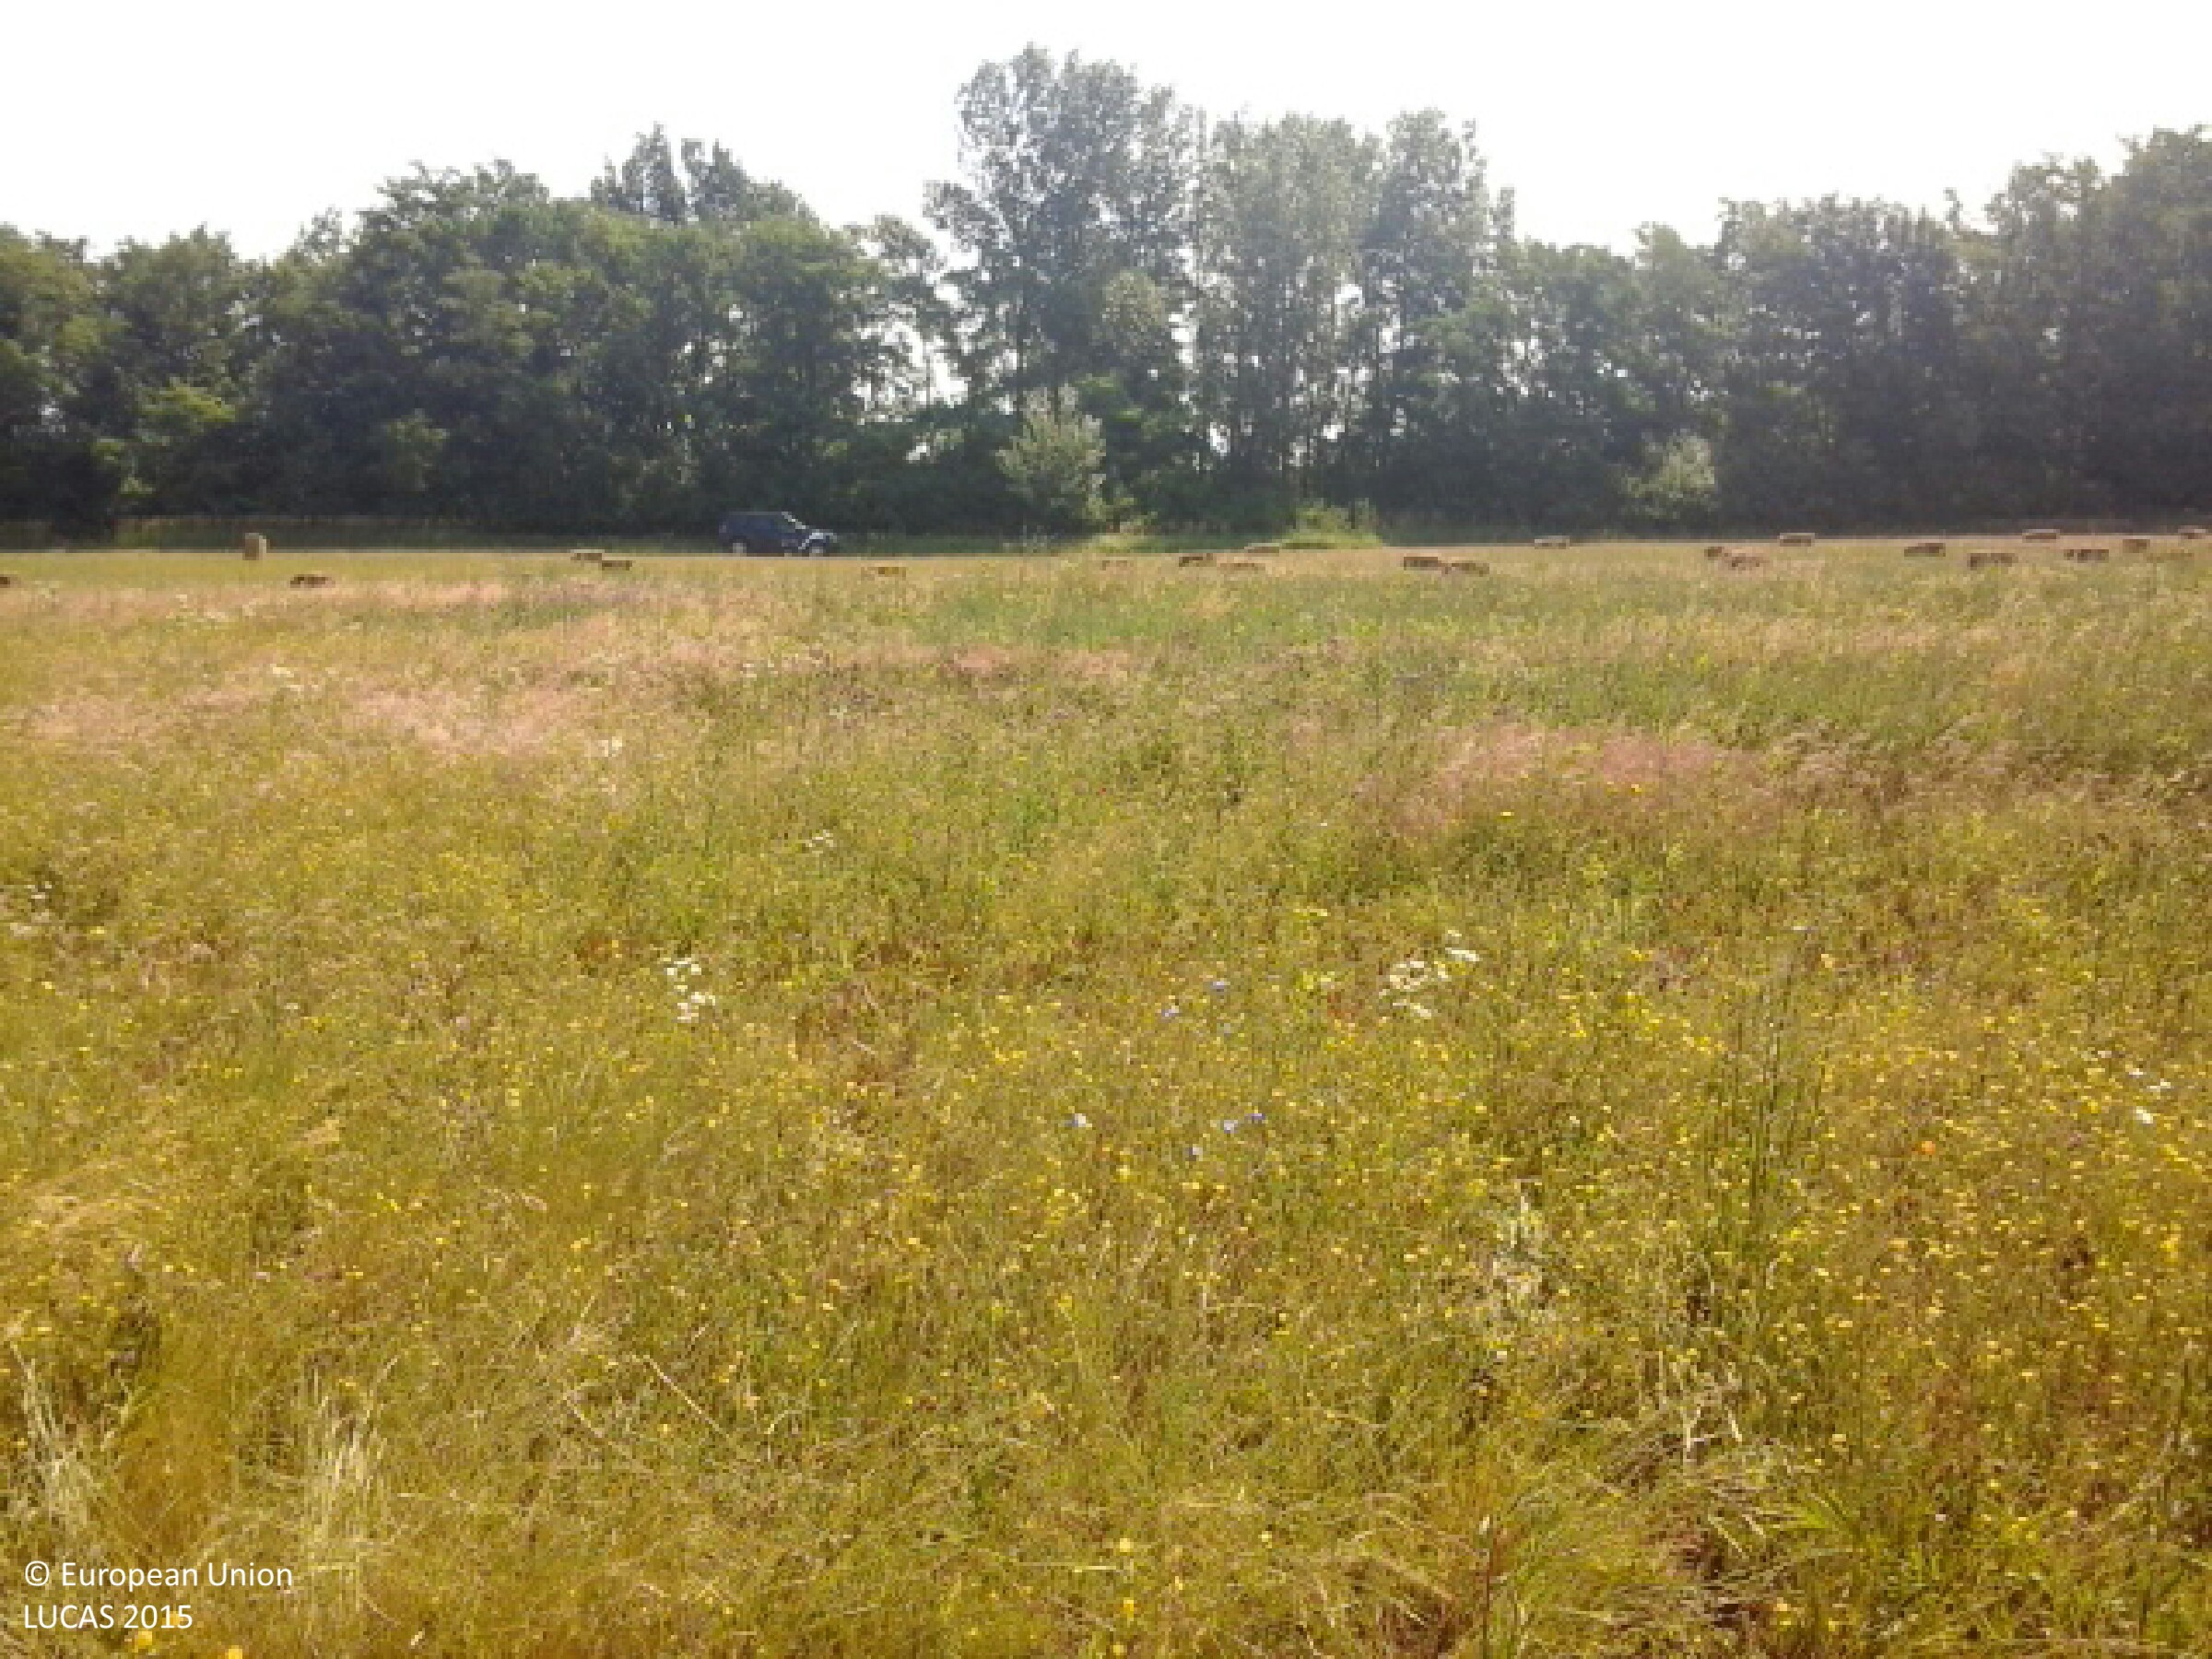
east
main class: Grassland
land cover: Grassland without tree/shrub cover
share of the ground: > 75 %
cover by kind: herbaceous plants 100 %
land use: Semi-natural and natural areas not in use
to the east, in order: Grassland without tree/shrub cover; Tracks; Grass margins; Broadleaved woodland; Ditches and canals; Broadleaved woodland; Sunflower
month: June
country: HU
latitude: 48.3179
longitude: 21.7690
